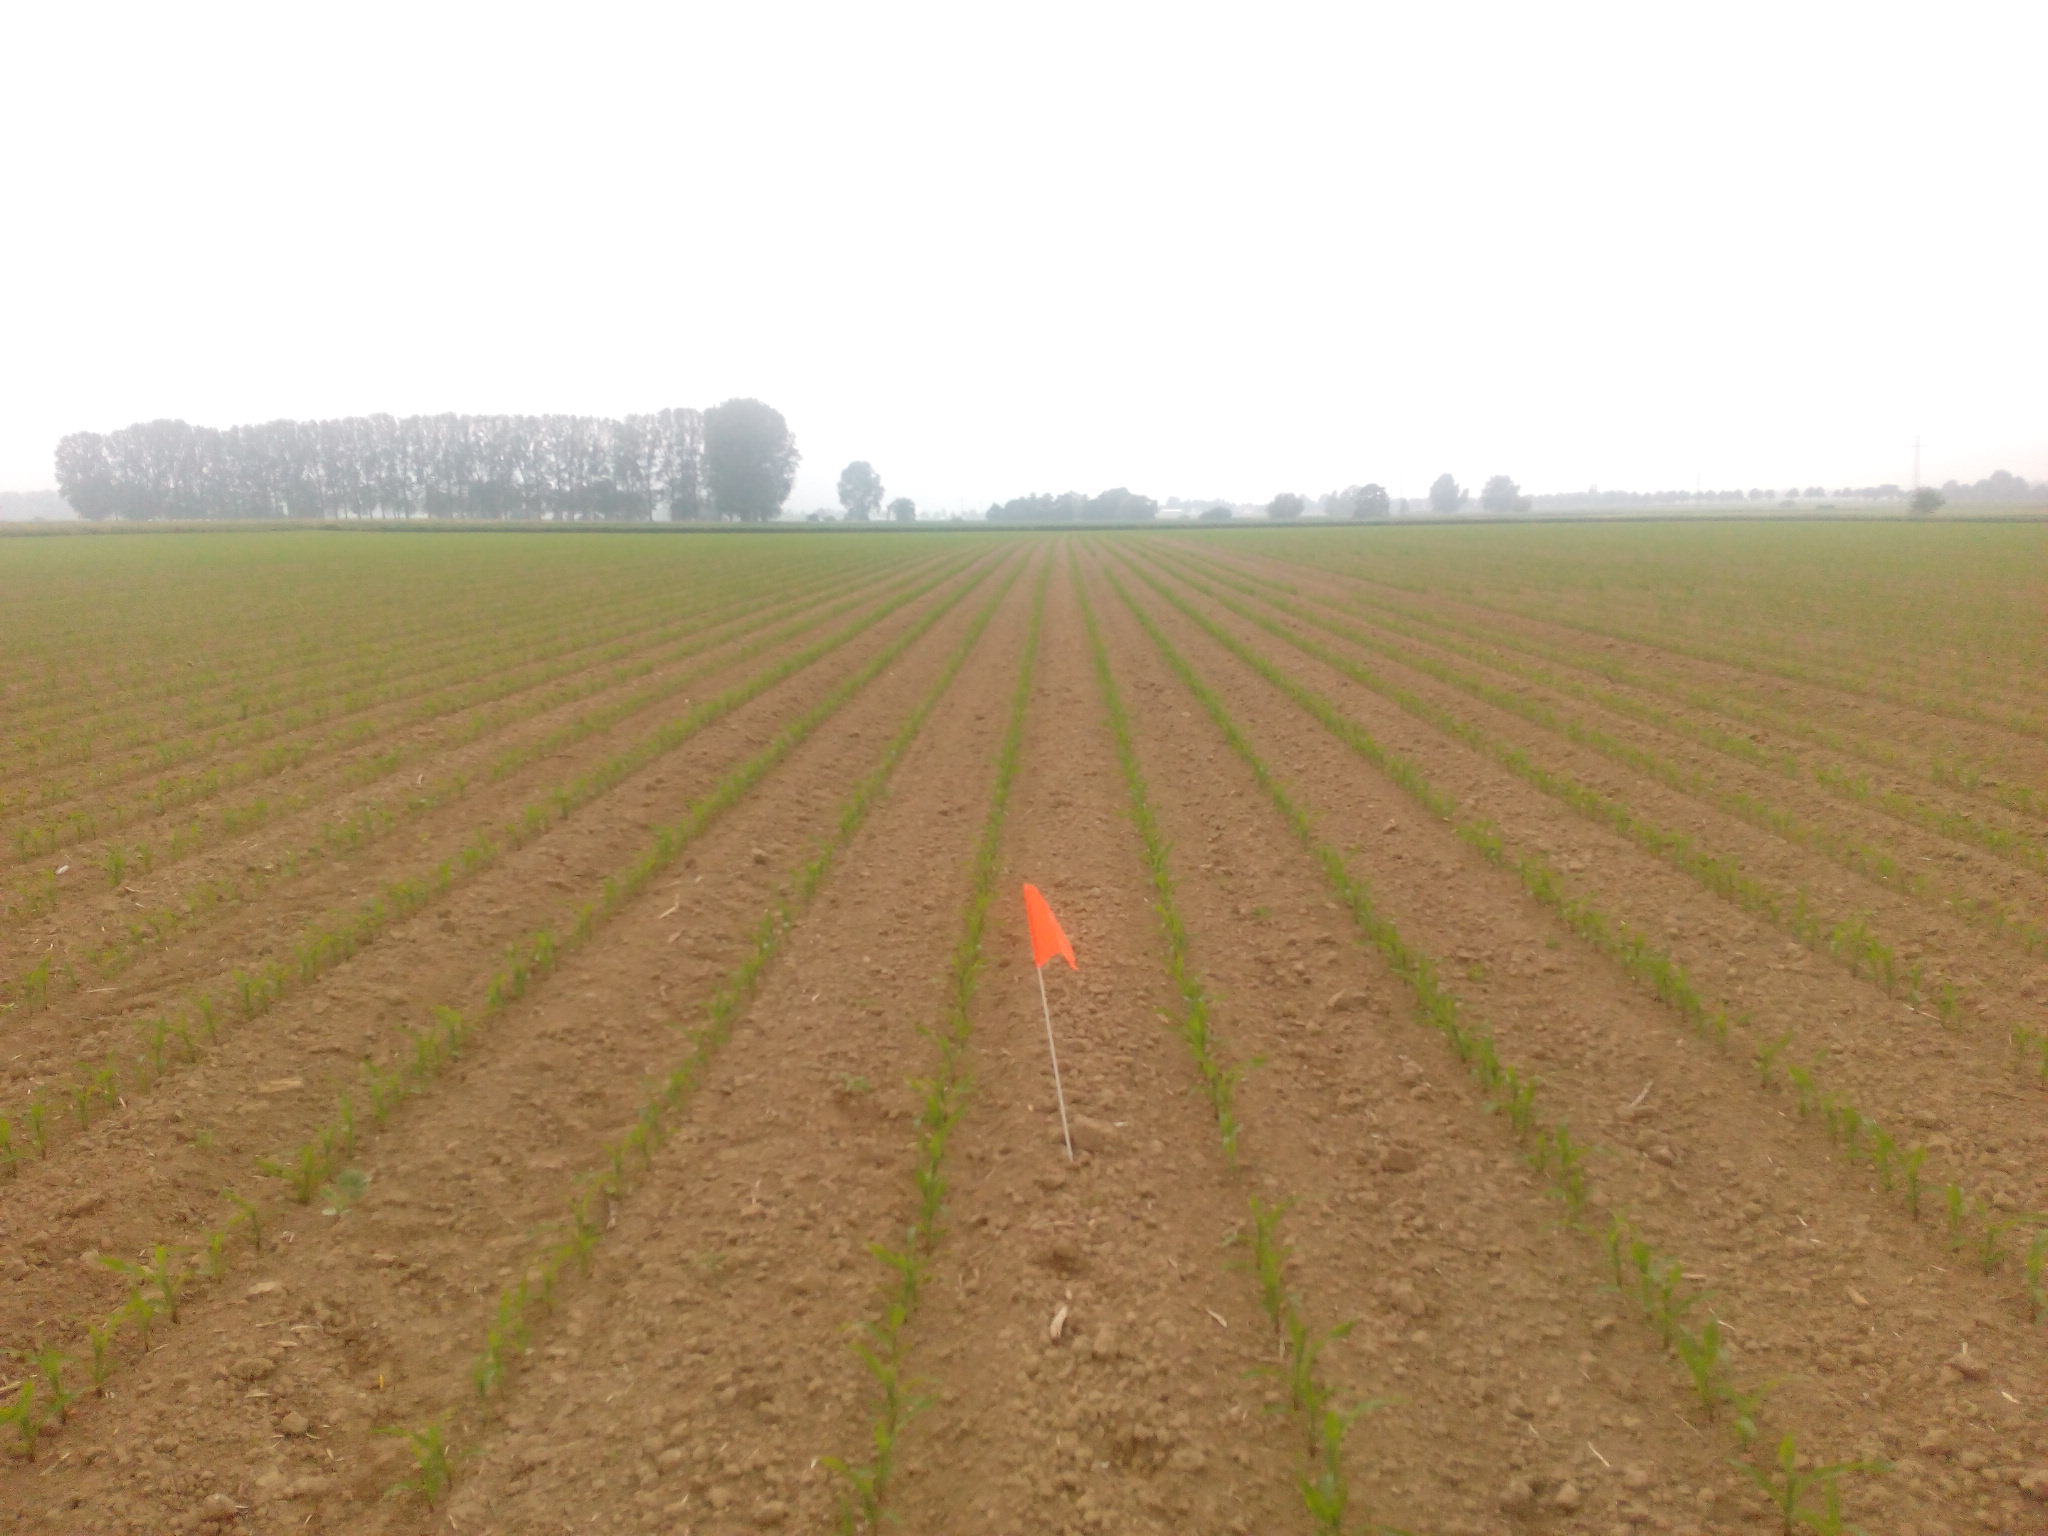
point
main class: Cropland
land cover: Maize
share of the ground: > 75 %
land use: Agriculture (excluding fallow land and kitchen gardens)
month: June
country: DE
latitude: 52.1972
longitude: 9.6344
